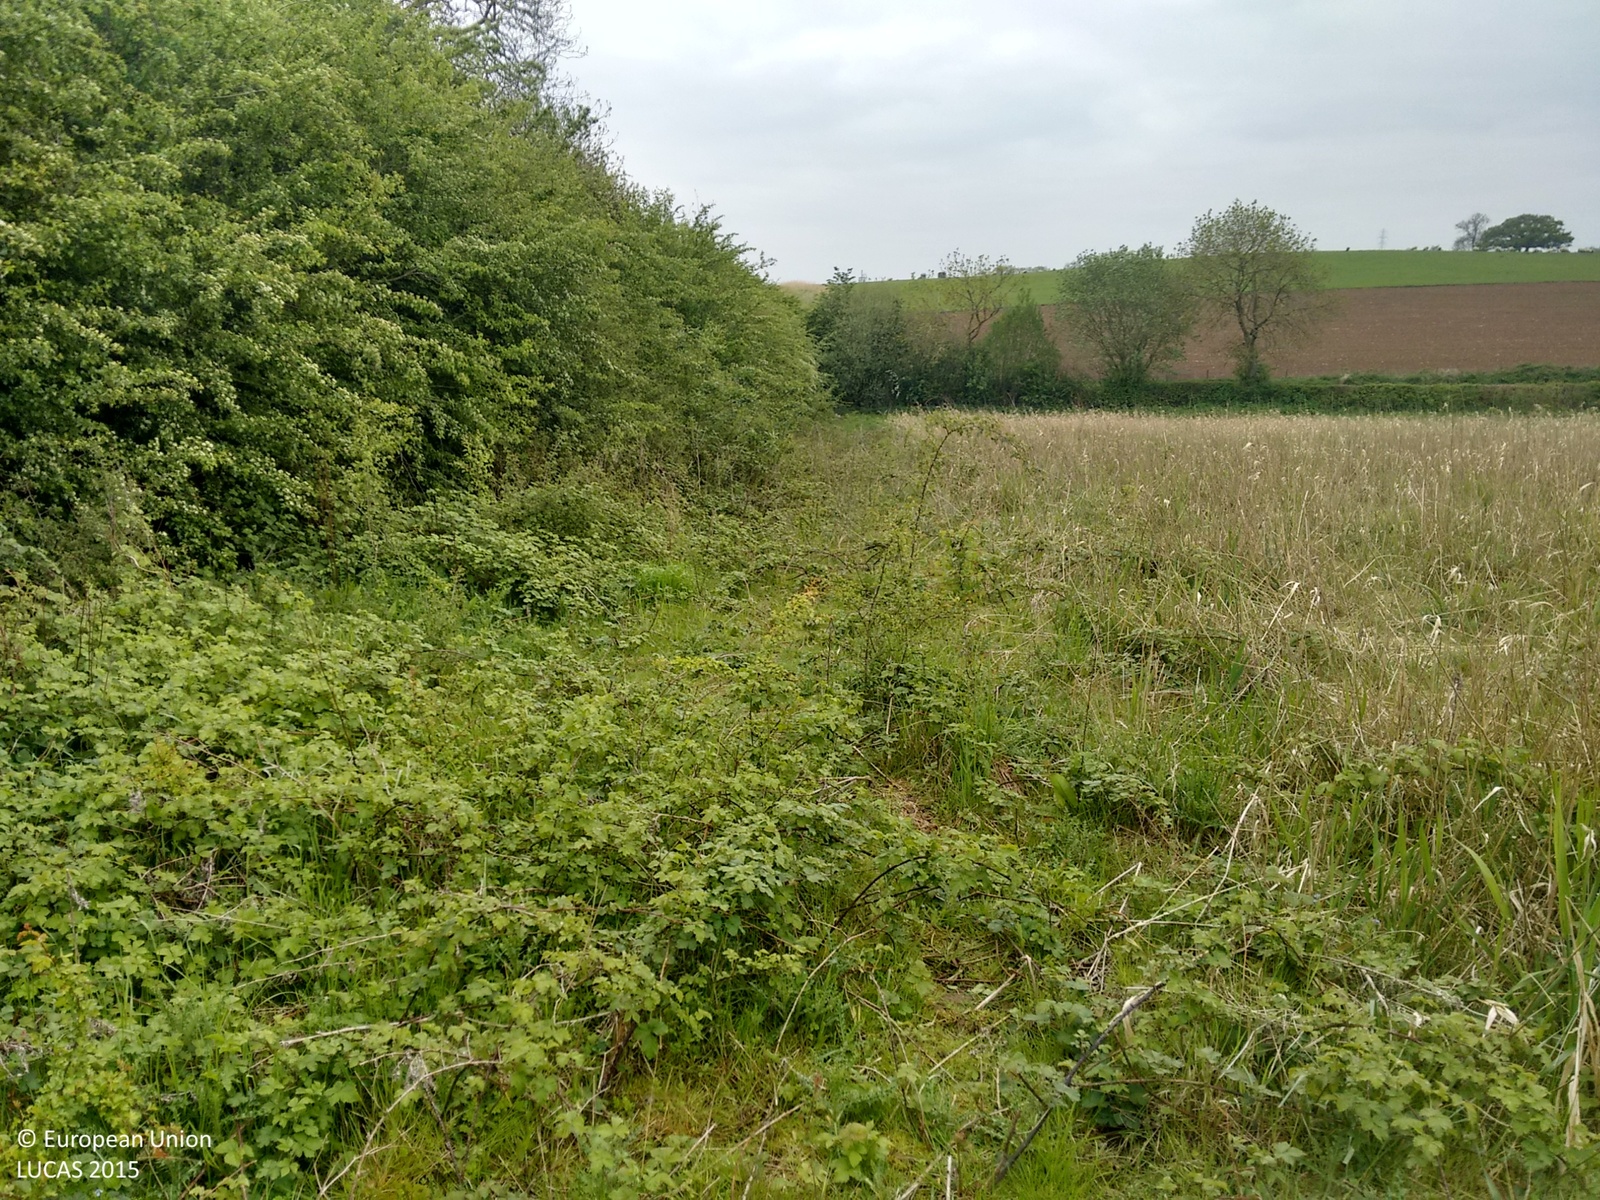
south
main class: Grassland
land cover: Grassland without tree/shrub cover
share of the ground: > 75 %
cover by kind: herbaceous plants 95 %, shrubs 5 %
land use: Agriculture (excluding fallow land and kitchen gardens)
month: May
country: GB
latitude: 52.4202
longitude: -1.2670
